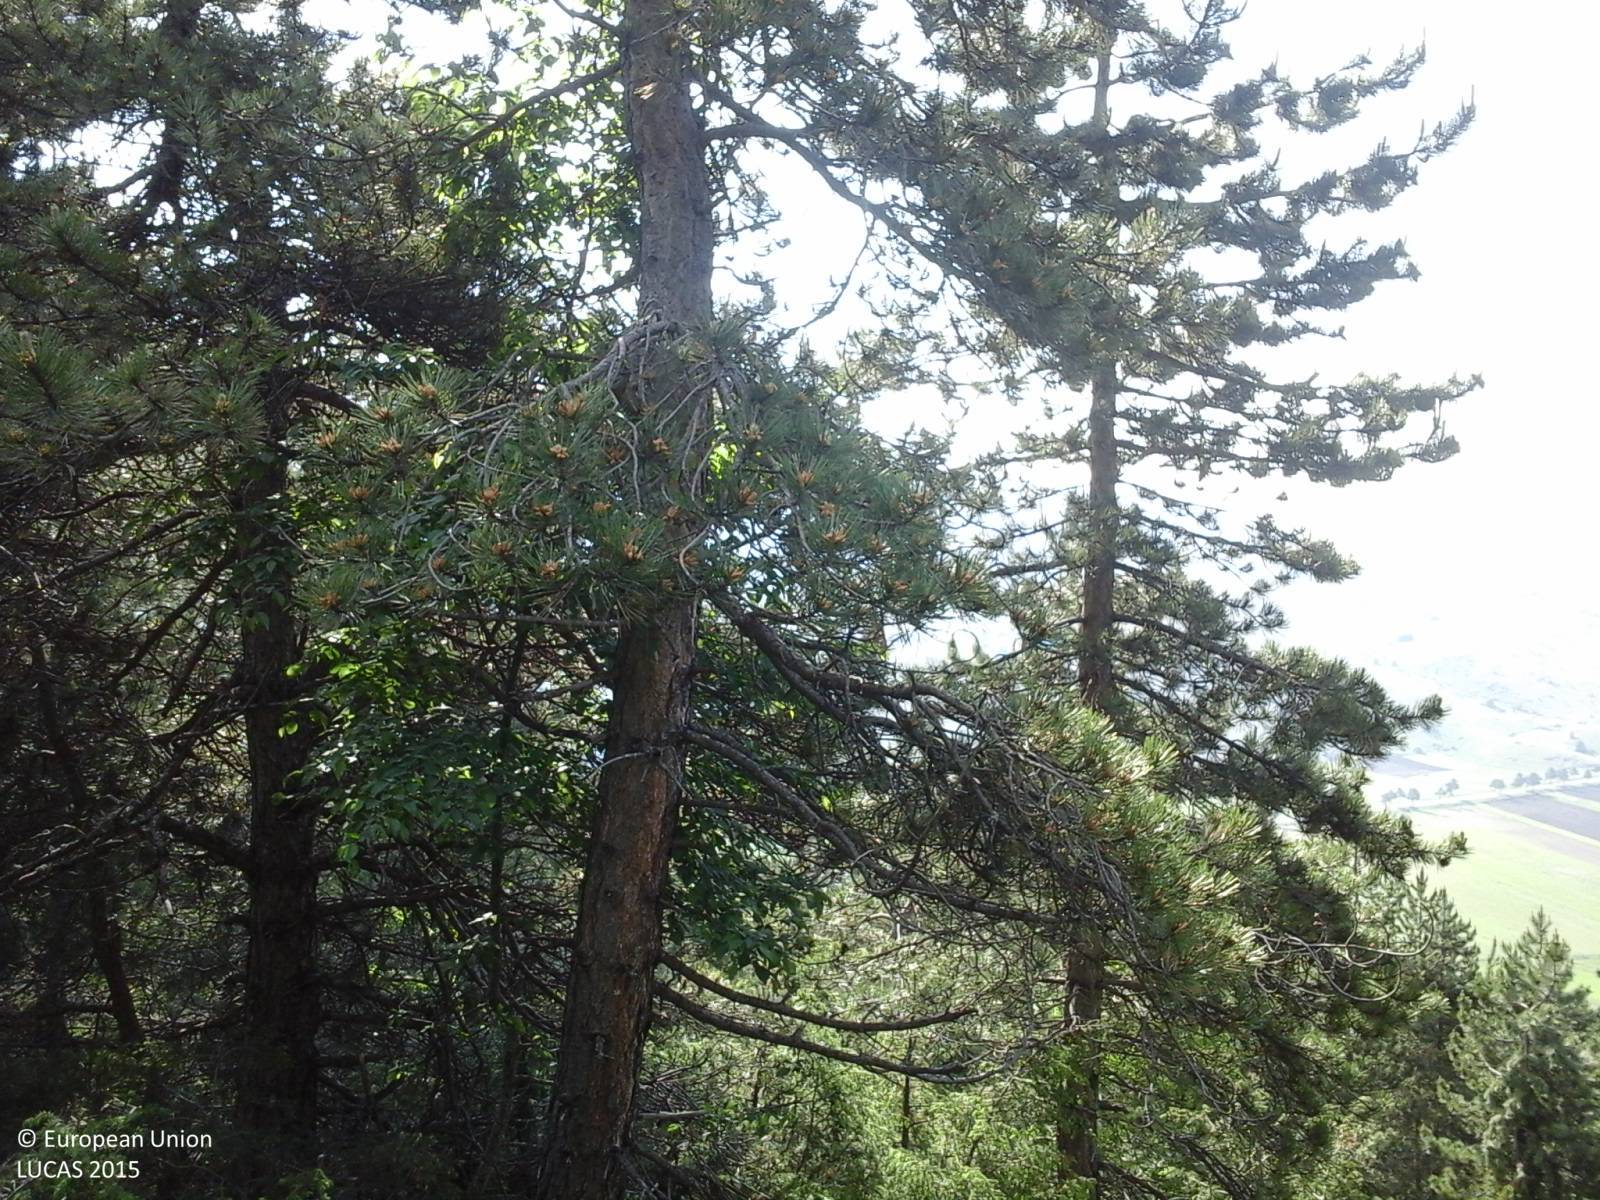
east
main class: Woodland
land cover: Pine dominated coniferous woodland
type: coniferous forest of the mediterranean region
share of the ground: 50 - 75 %
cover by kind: coniferous forest trees 65 %, shrubs 25 %, herbaceous plants 10 %
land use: Semi-natural and natural areas not in use
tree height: > 5 m
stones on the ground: 25 - 50 %
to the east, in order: Pine dominated coniferous woodland; Shrubland with sparse tree cover; Pine dominated coniferous woodland
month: June
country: IT
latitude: 41.9068
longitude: 13.9767
